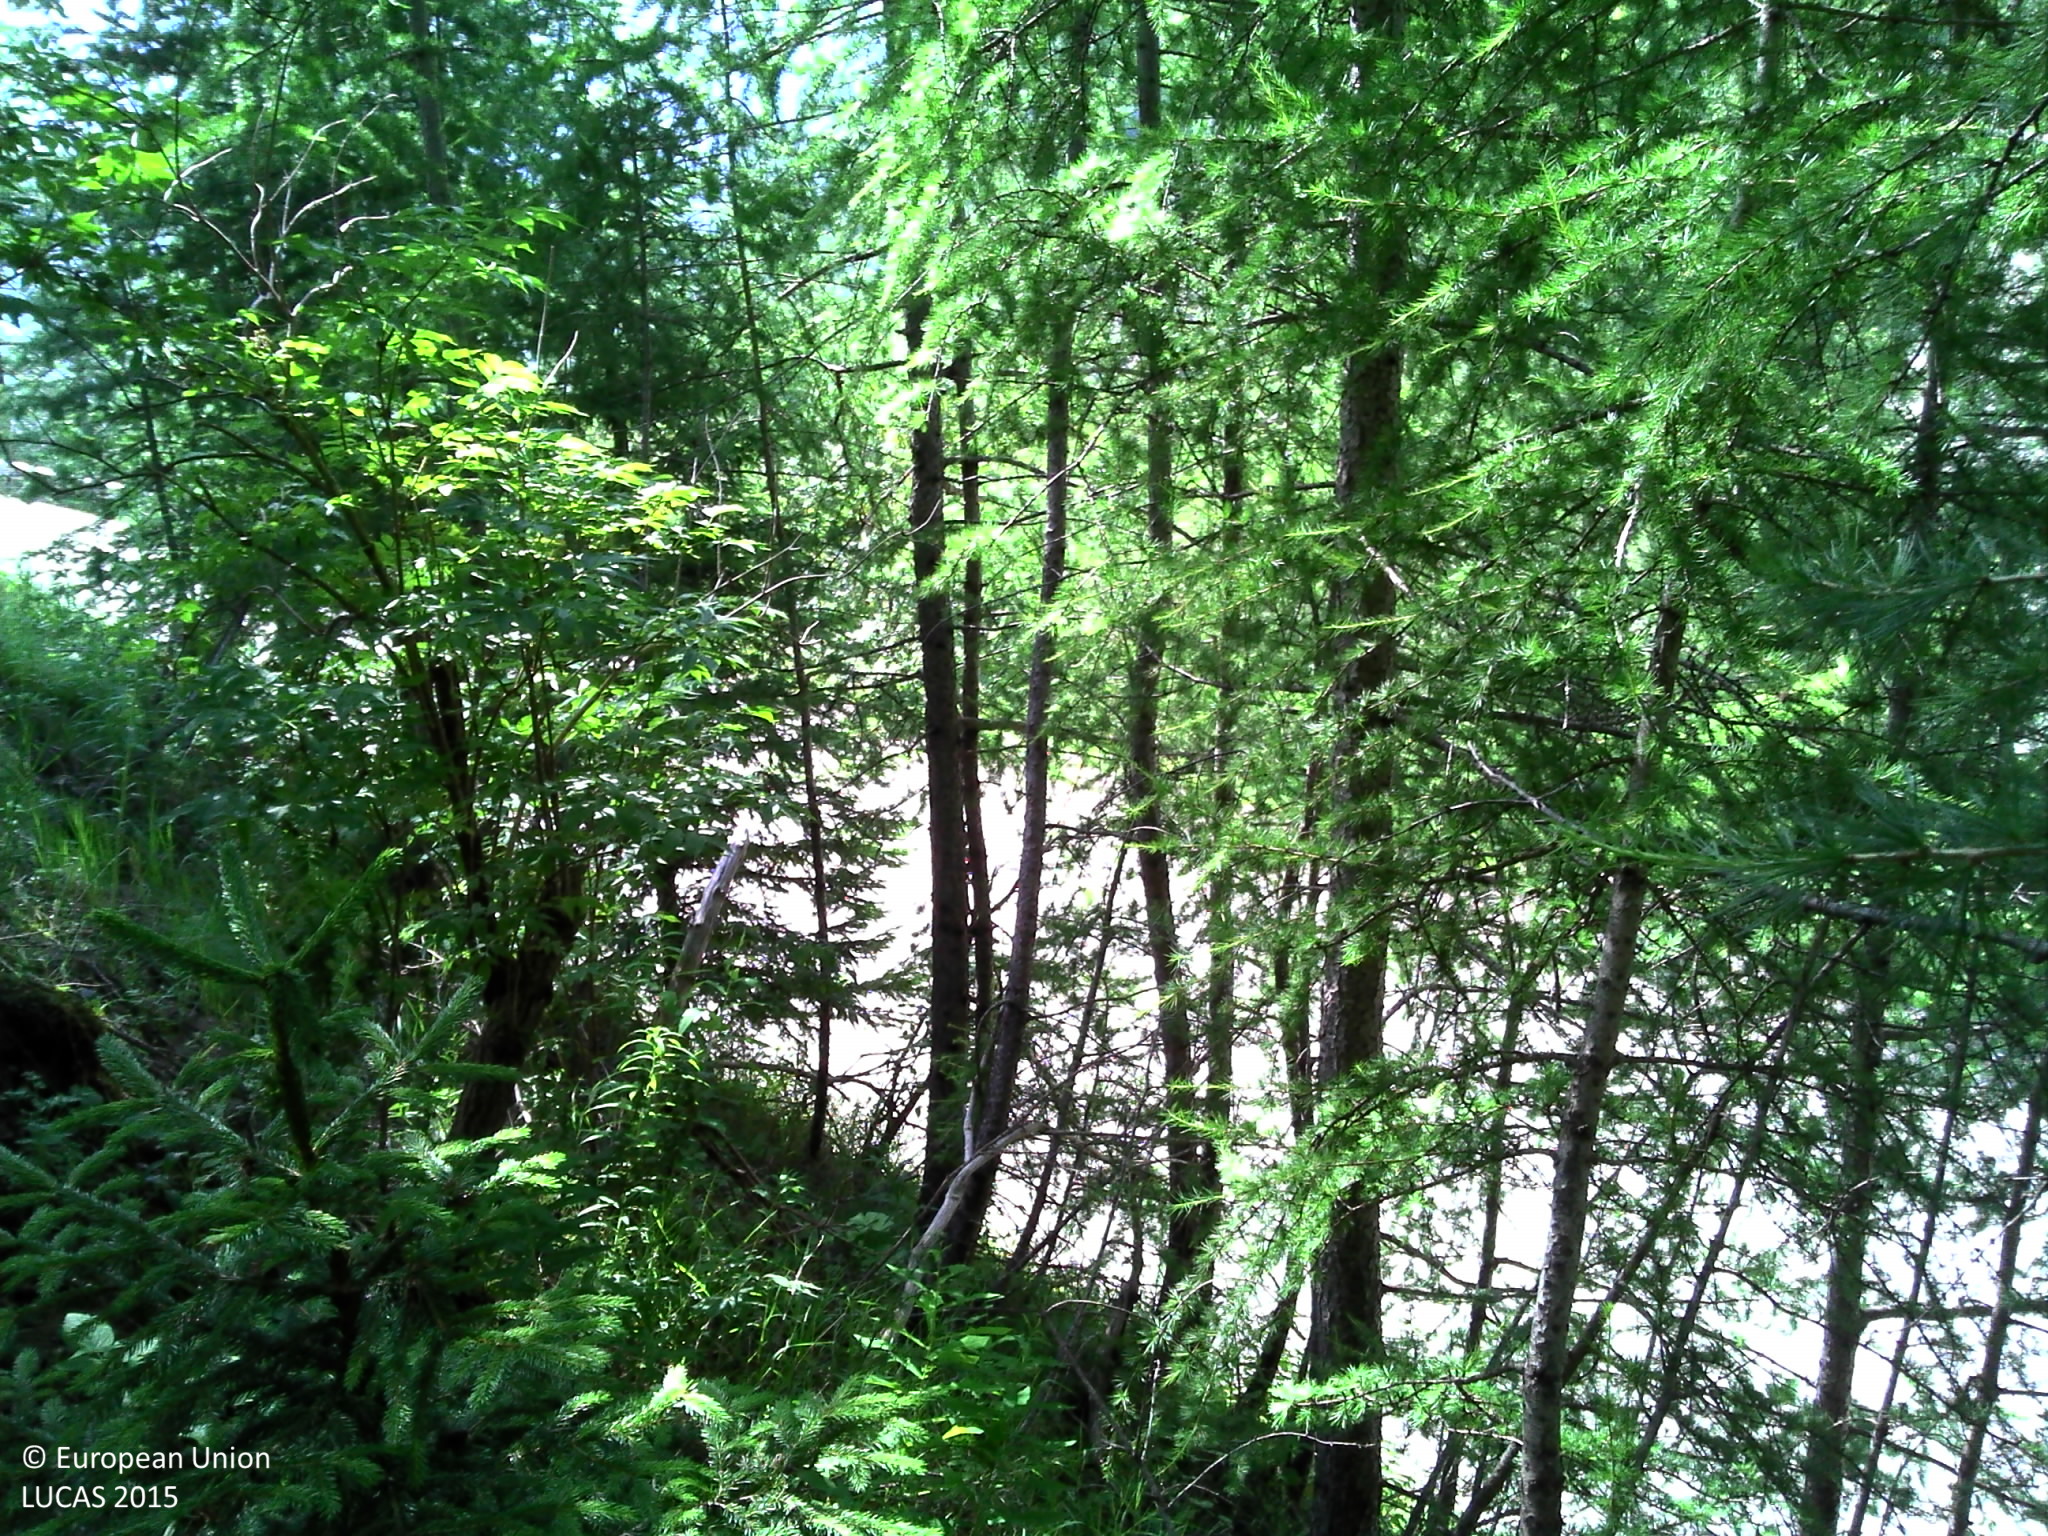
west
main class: Woodland
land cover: Other coniferous woodland
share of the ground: > 75 %
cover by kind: coniferous forest trees 60 %, broadleaved forest trees 20 %, herbaceous plants 15 %, unconsolidated bare surface 5 %
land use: Semi-natural and natural areas not in use
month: June
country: FR
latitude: 44.2015
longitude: 7.0906
